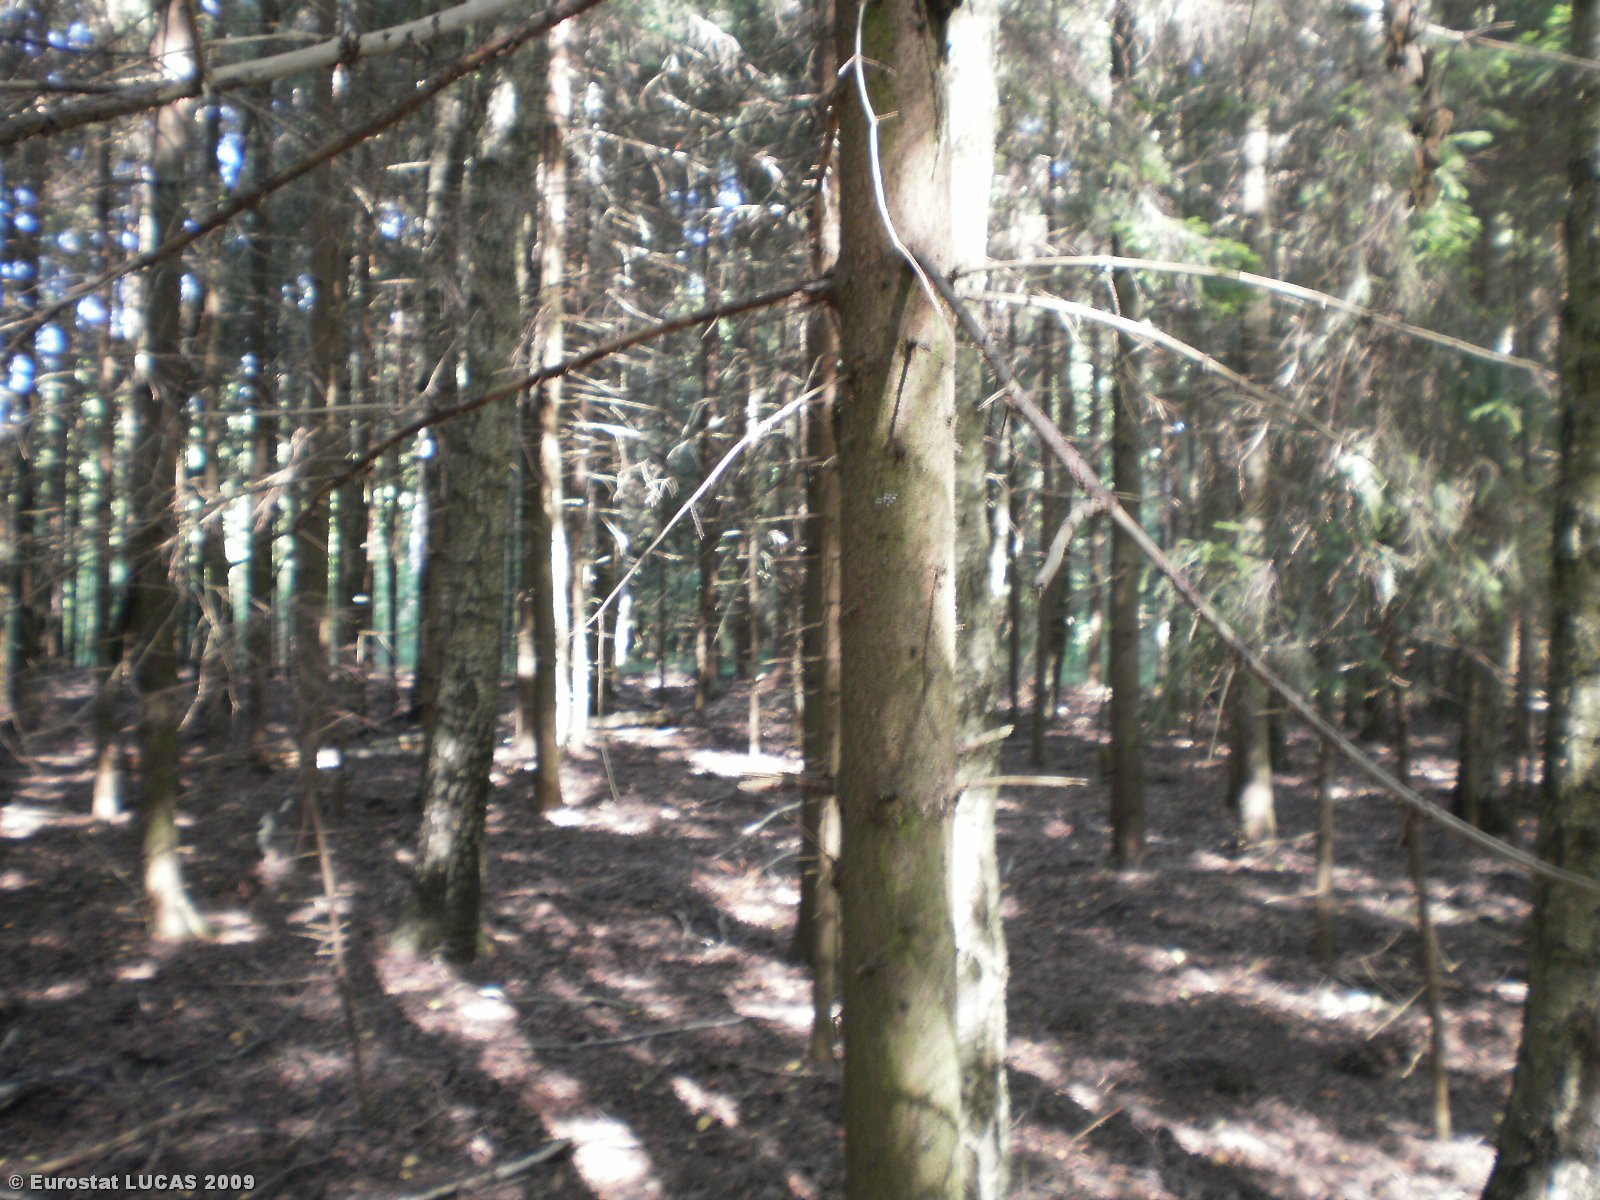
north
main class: Woodland
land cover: Coniferous woodland
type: hemiboreal forest and nemoral coniferous forest and mixed broadleaved-coniferous forest
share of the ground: > 75 %
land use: Forestry
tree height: > 5 m
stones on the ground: < 10 %
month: August
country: LT
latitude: 55.7507
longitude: 25.2037
